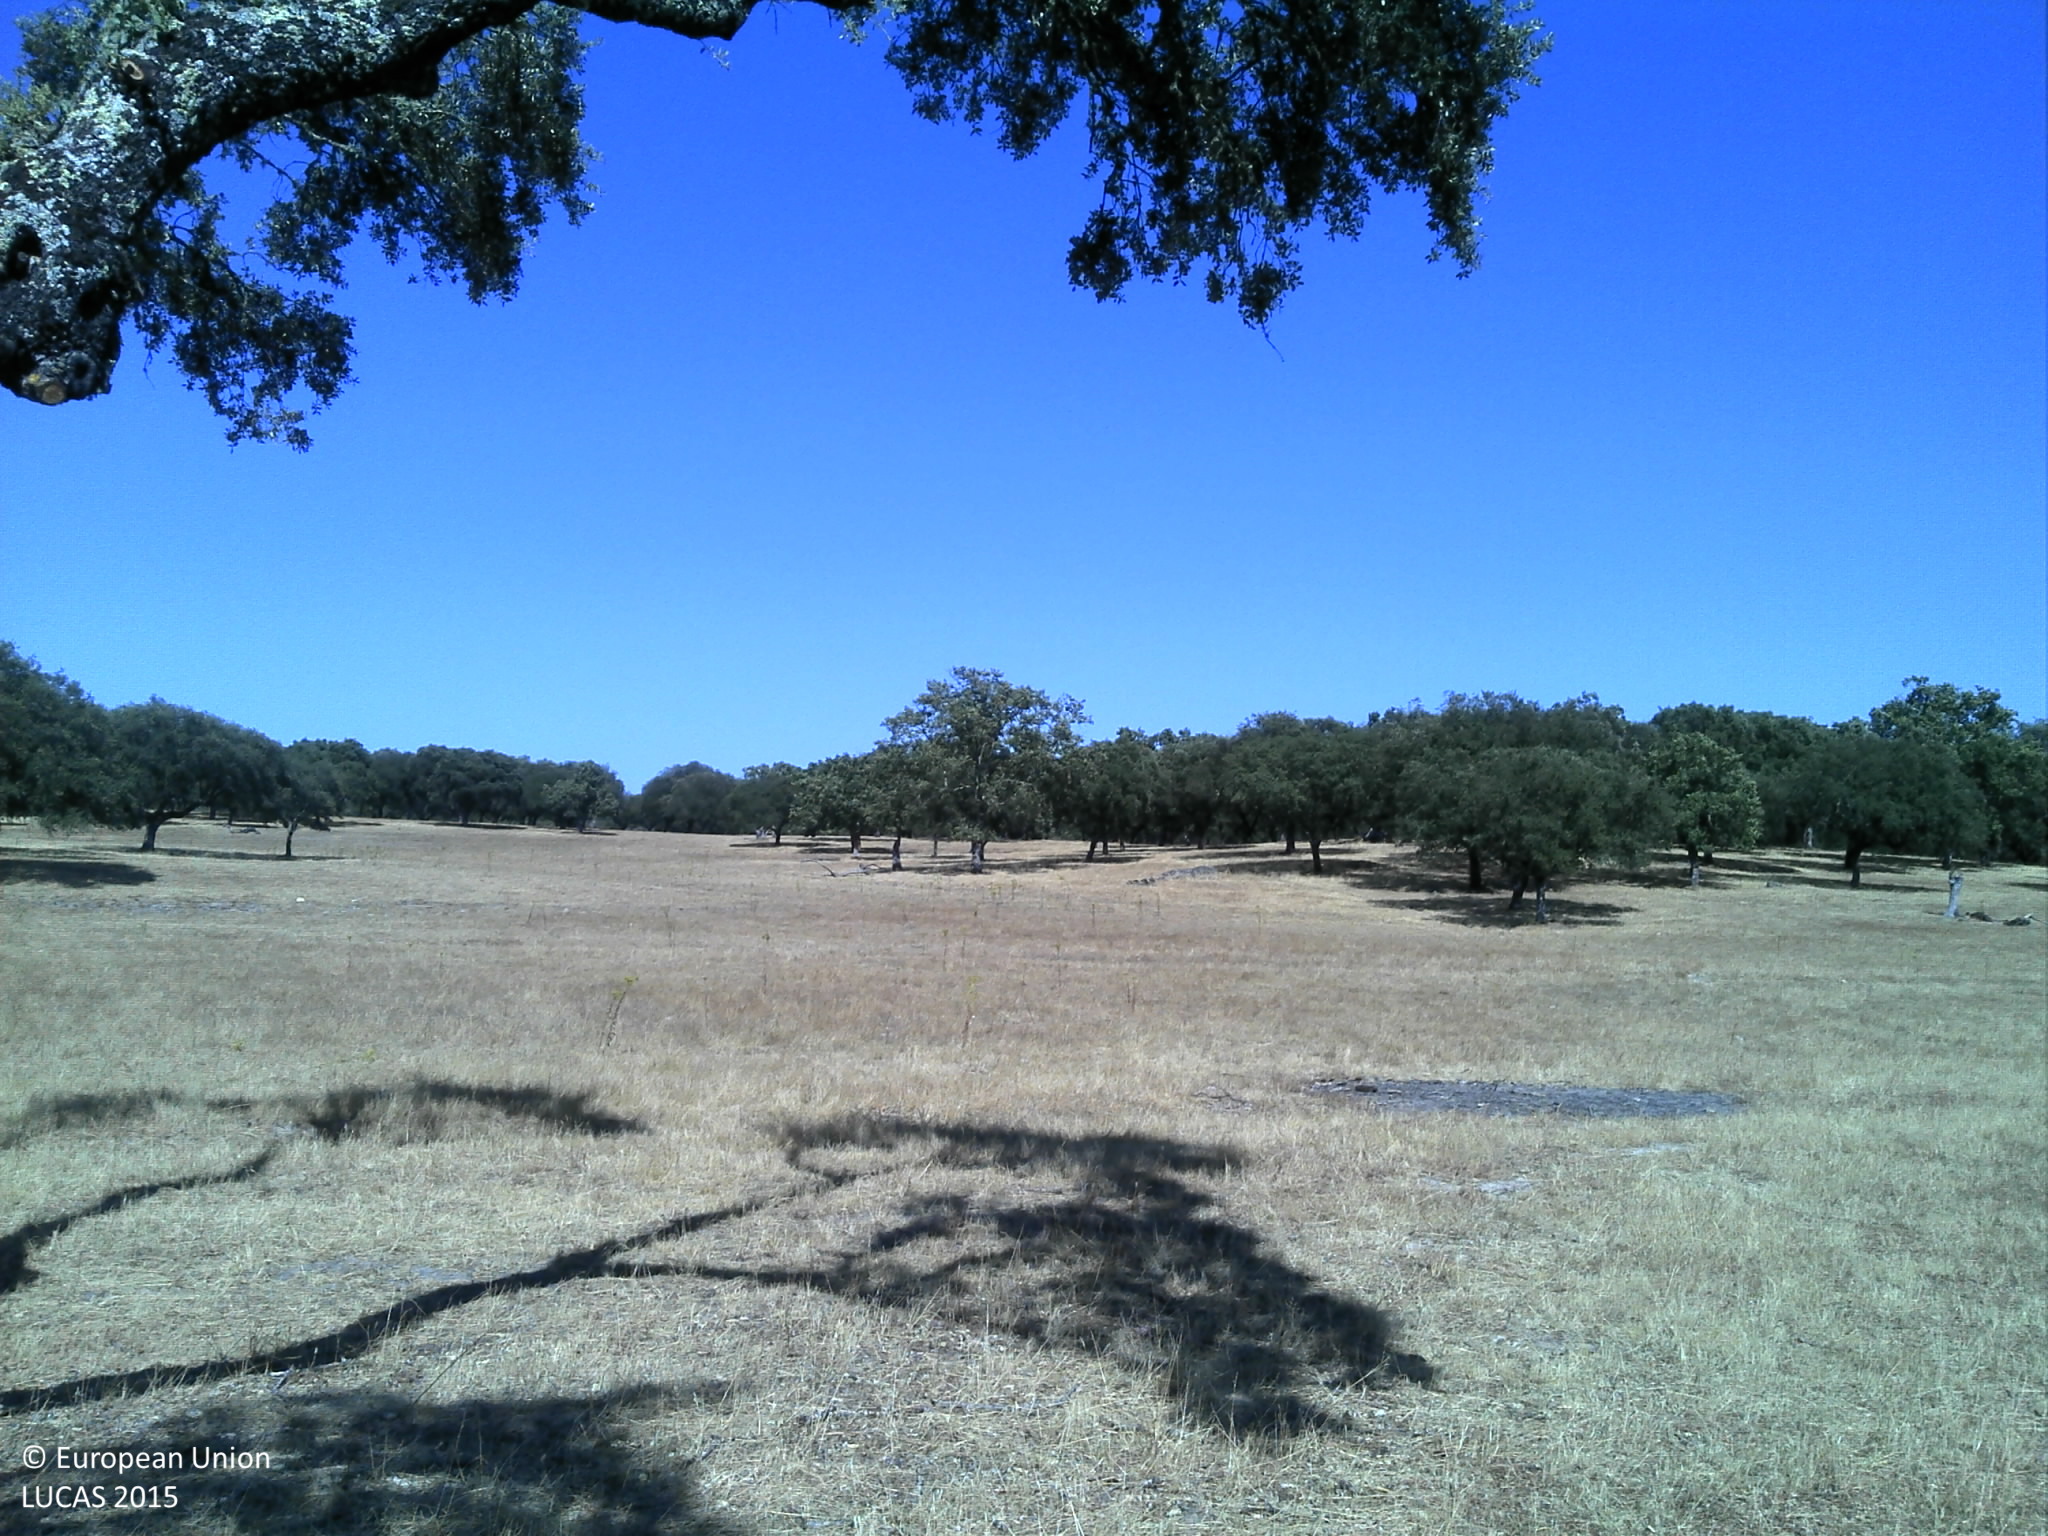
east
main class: Woodland
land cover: Broadleaved woodland
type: broadleaved evergreen forest
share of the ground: 25 - 50 %
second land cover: Grassland without tree/shrub cover
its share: 10 - 25 %
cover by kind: unconsolidated bare surface 50 %, broadleaved forest trees 30 %, herbaceous plants 20 %
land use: Forestry
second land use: Agriculture (excluding fallow land and kitchen gardens)
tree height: > 5 m
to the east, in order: Broadleaved woodland; Grassland without tree/shrub cover; Broadleaved woodland; Grassland without tree/shrub cover; Rivers and streams; Grassland without tree/shrub cover; Broadleaved woodland
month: July
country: PT
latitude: 39.3408
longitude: -7.6248
